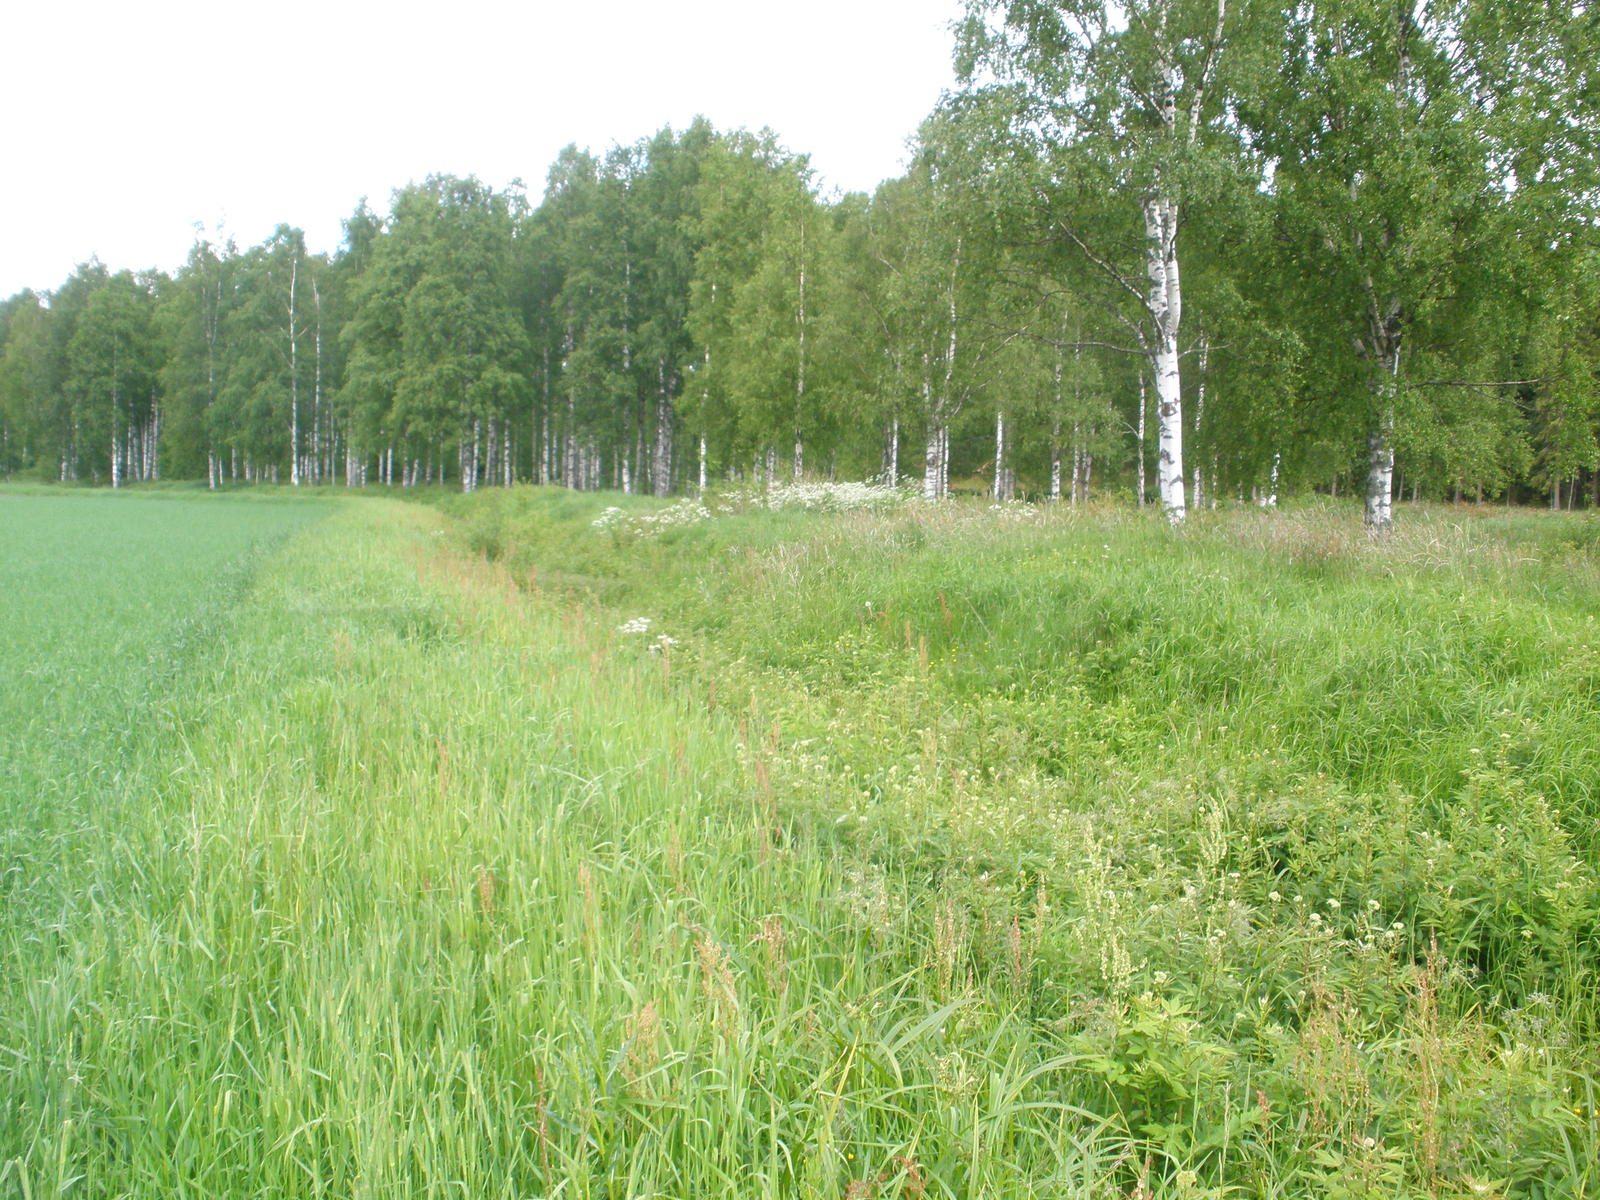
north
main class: Cropland
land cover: Oats
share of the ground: > 75 %
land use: Agriculture (excluding fallow land and kitchen gardens)
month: June
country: FI
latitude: 61.0318
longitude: 23.2762
